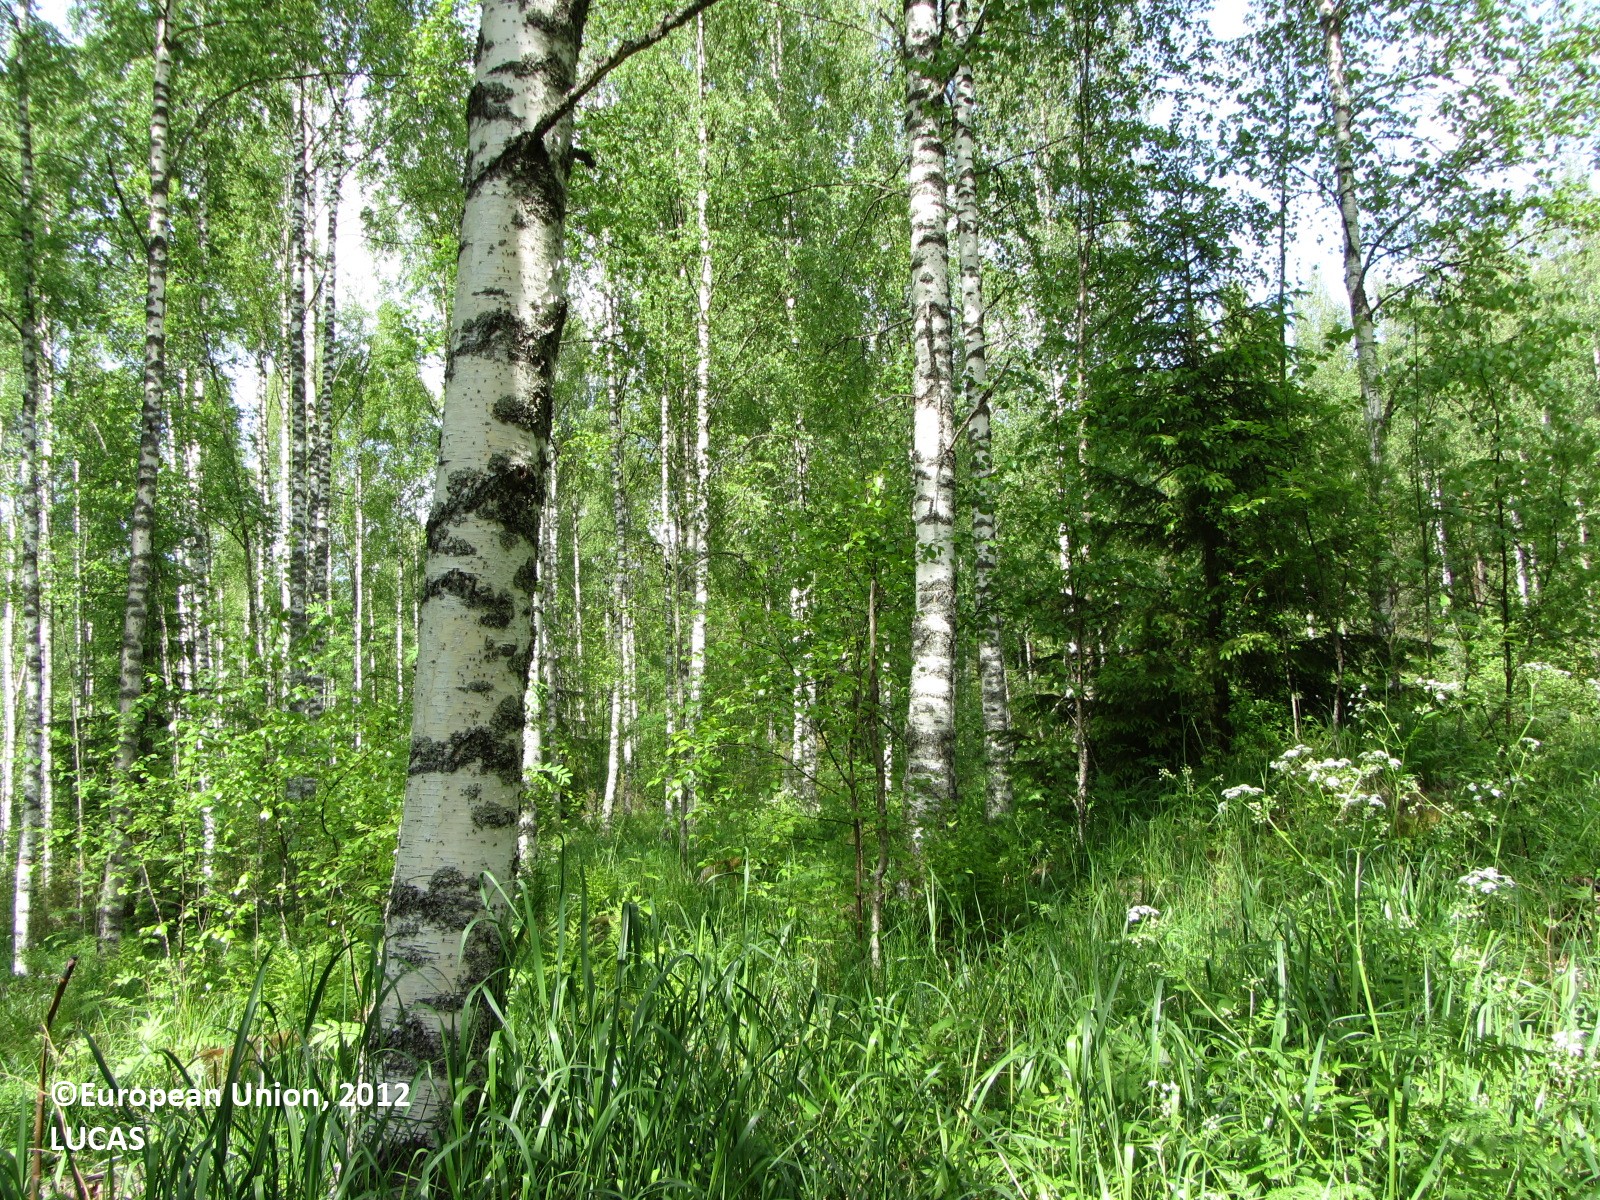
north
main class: Woodland
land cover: Broadleaved woodland
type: hemiboreal forest and nemoral coniferous forest and mixed broadleaved-coniferous forest
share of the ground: 50 - 75 %
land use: Forestry
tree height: > 5 m
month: June
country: FI
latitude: 61.9613
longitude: 25.0376
